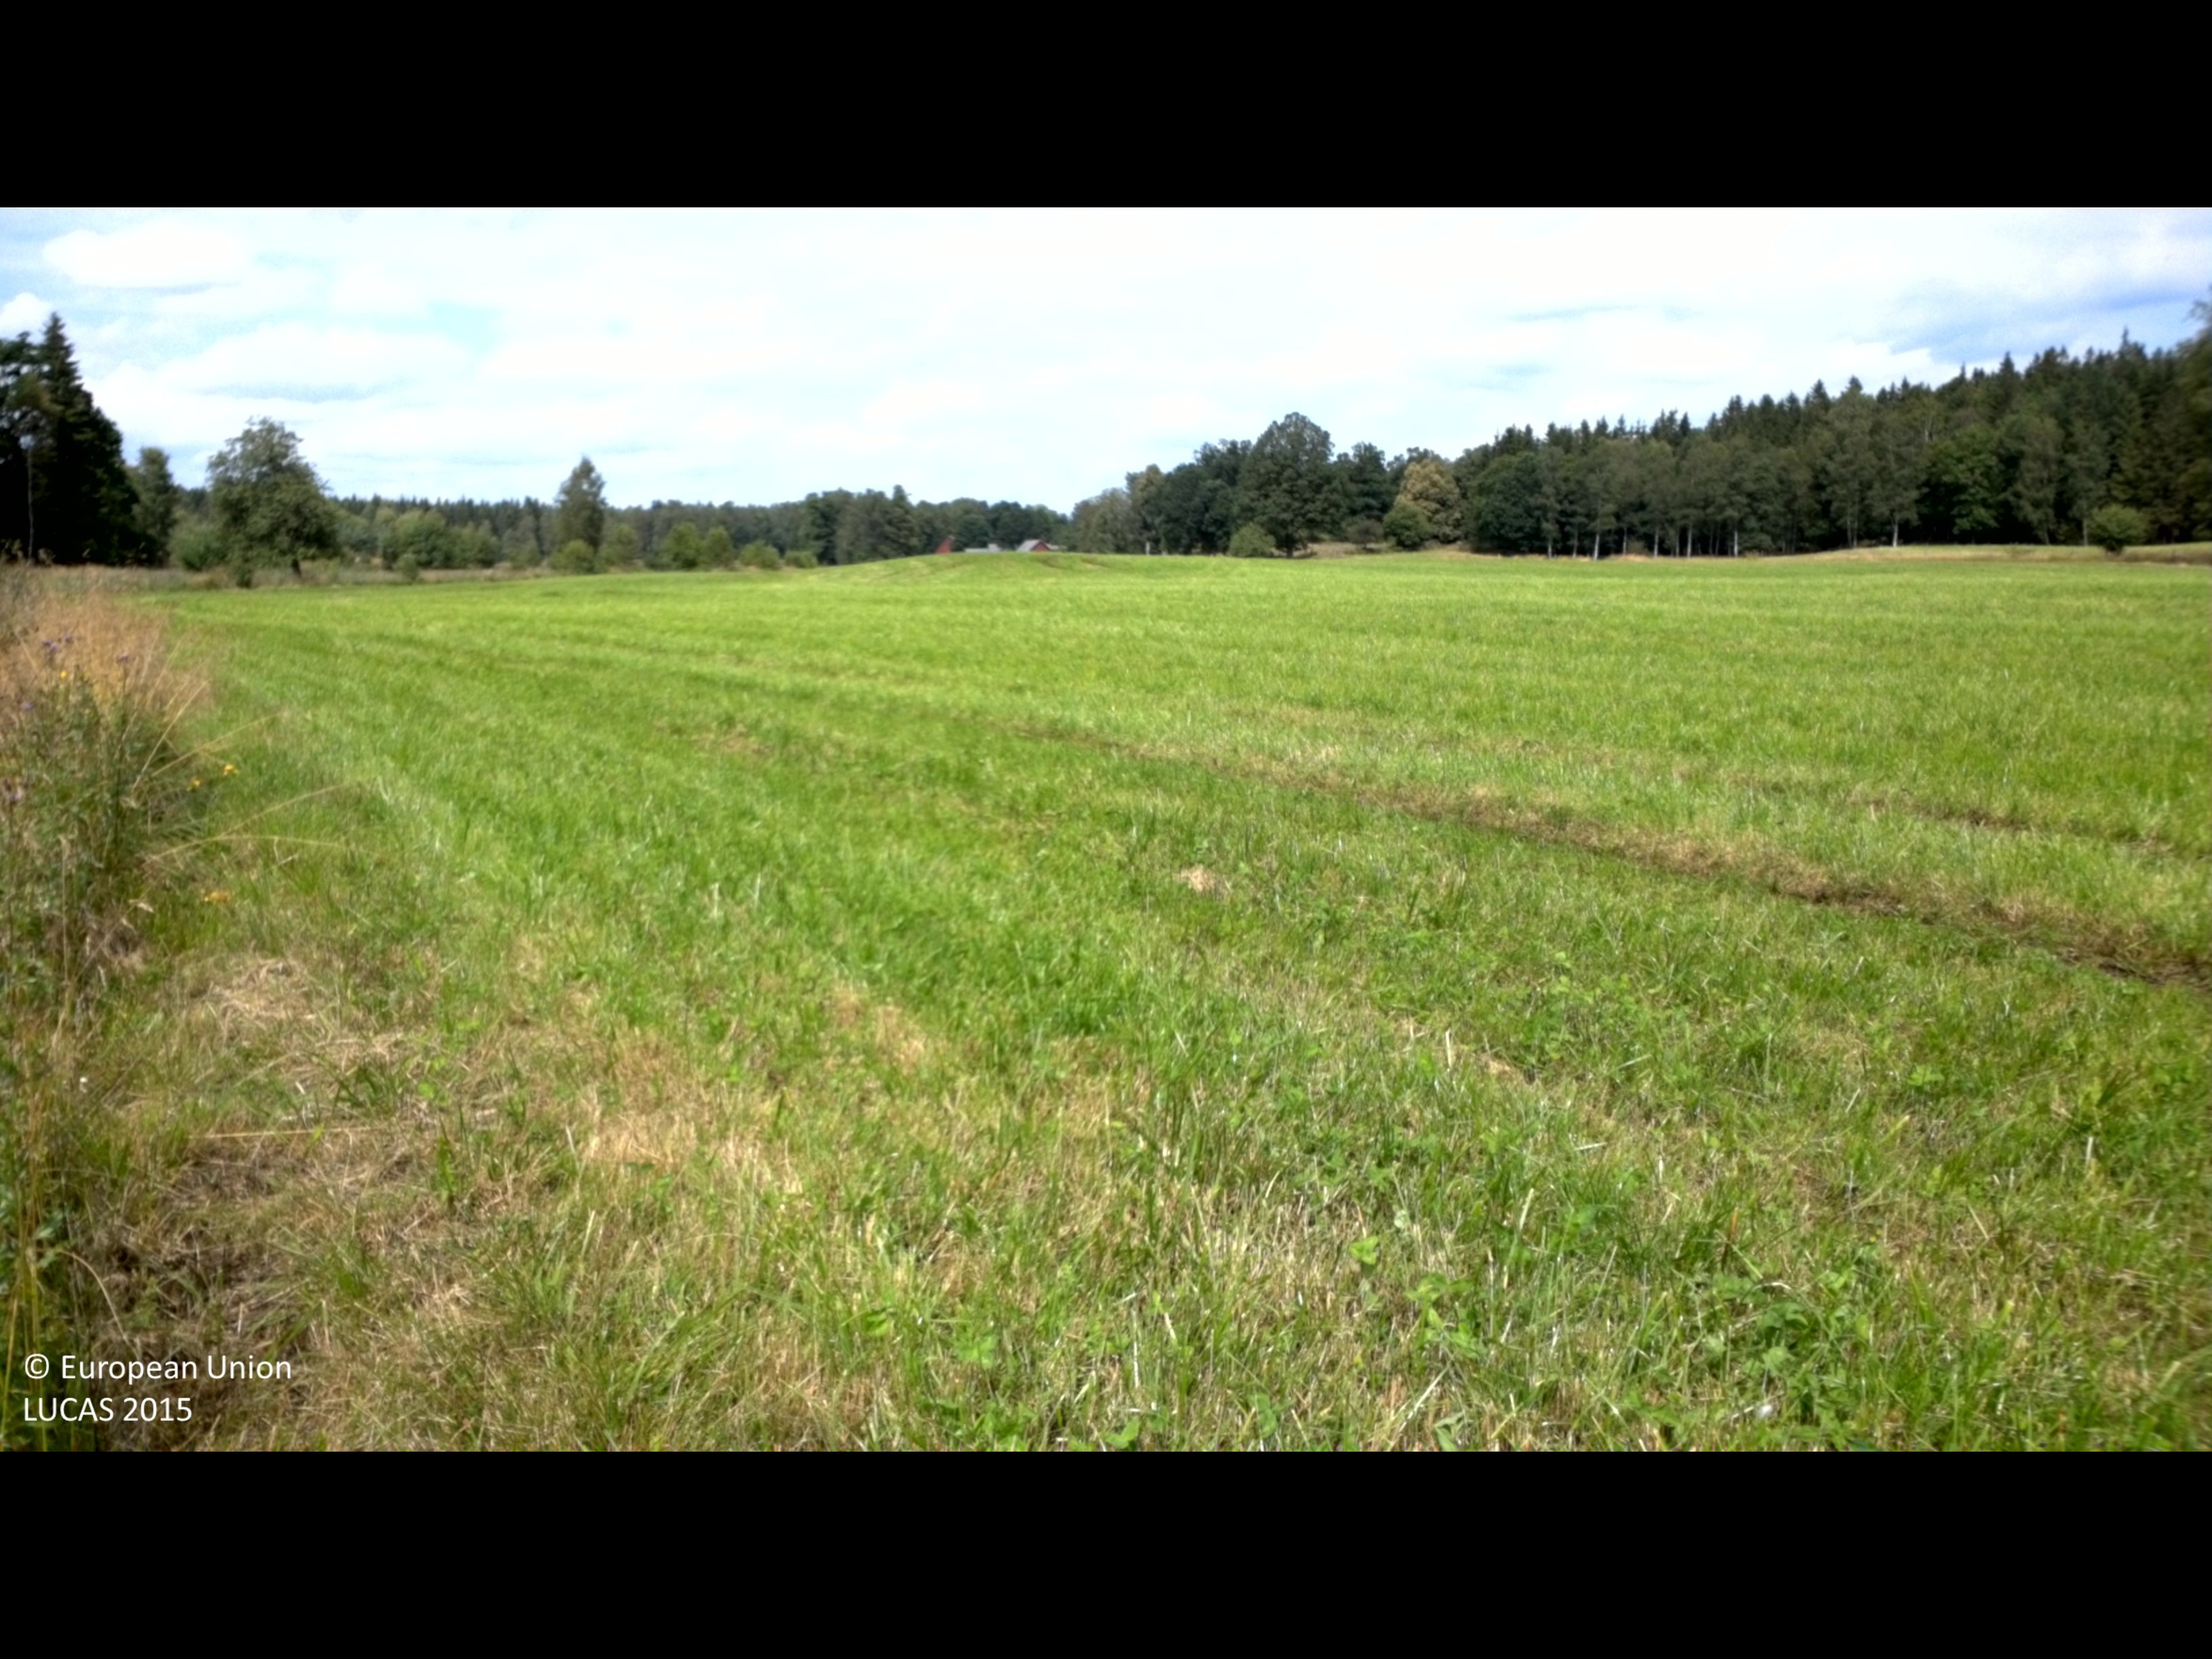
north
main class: Cropland
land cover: Temporary grasslands
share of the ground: > 75 %
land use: Agriculture (excluding fallow land and kitchen gardens)
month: August
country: SE
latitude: 56.3862
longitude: 14.2896
